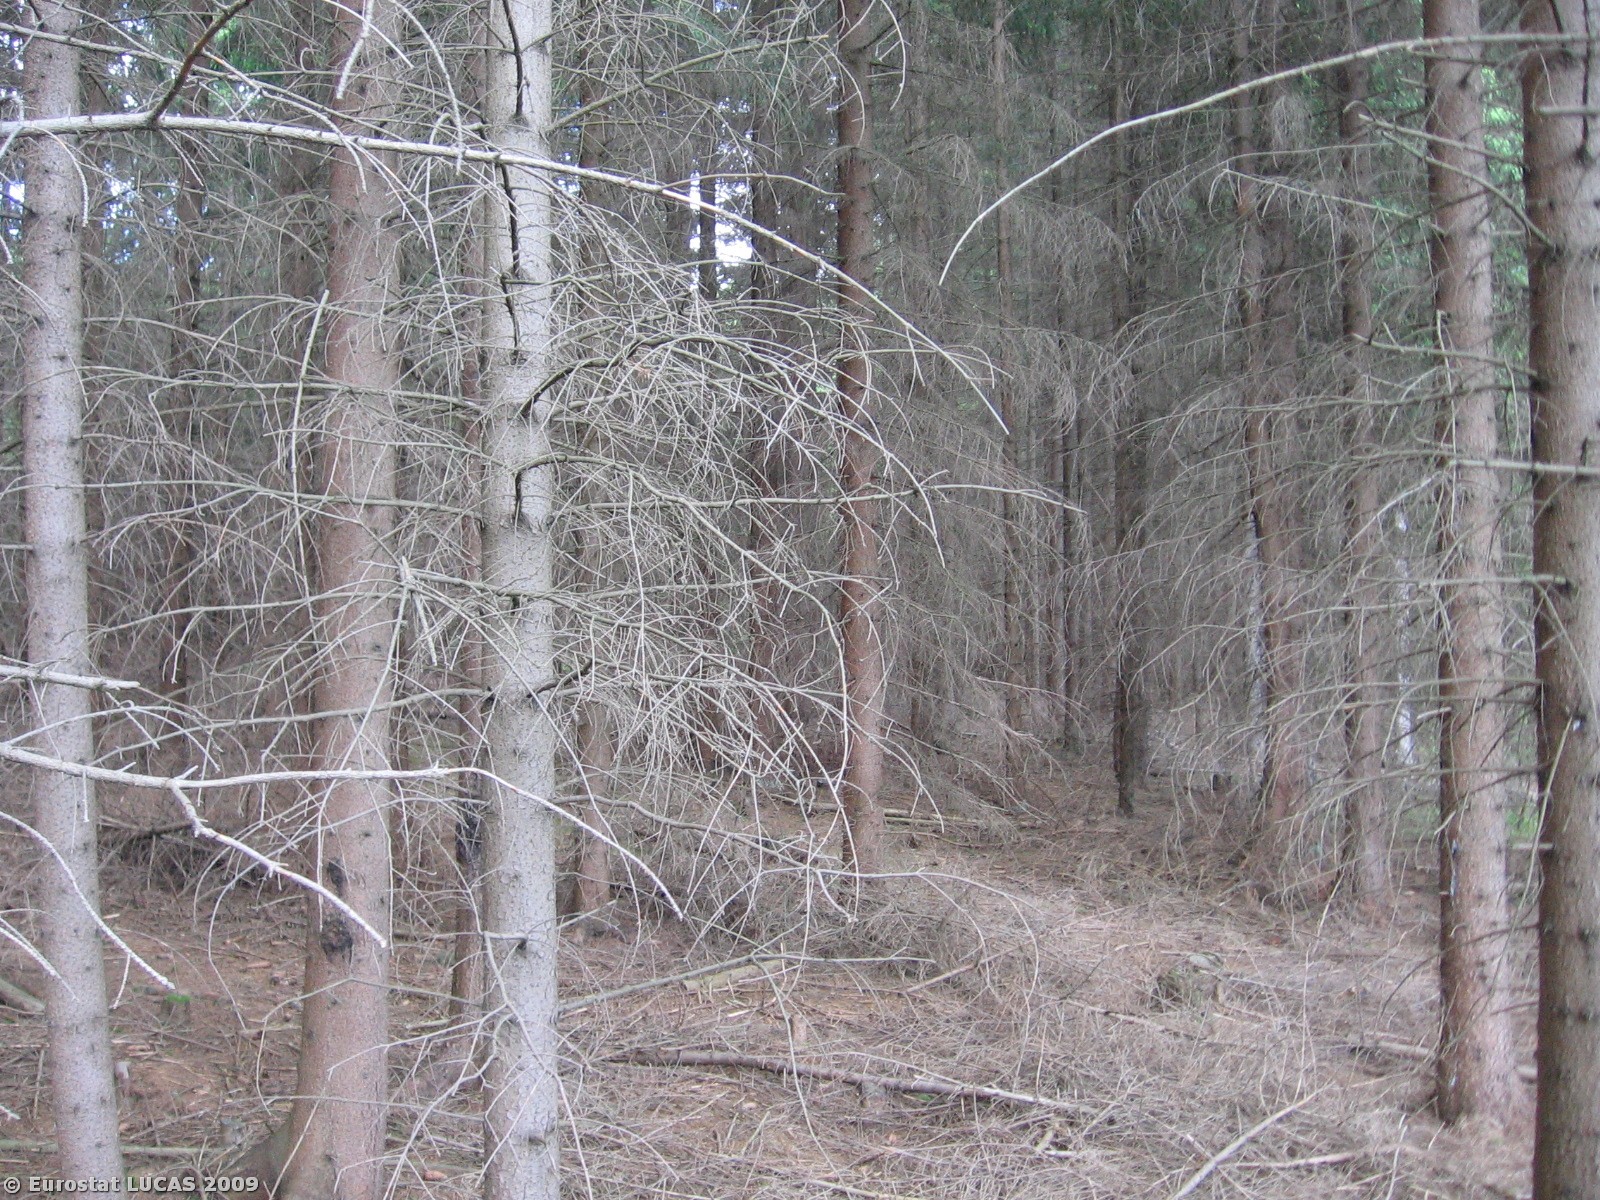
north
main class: Woodland
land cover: Coniferous woodland
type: hemiboreal forest and nemoral coniferous forest and mixed broadleaved-coniferous forest
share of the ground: > 75 %
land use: Forestry
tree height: > 5 m
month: June
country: CZ
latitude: 49.0571
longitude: 13.8456
